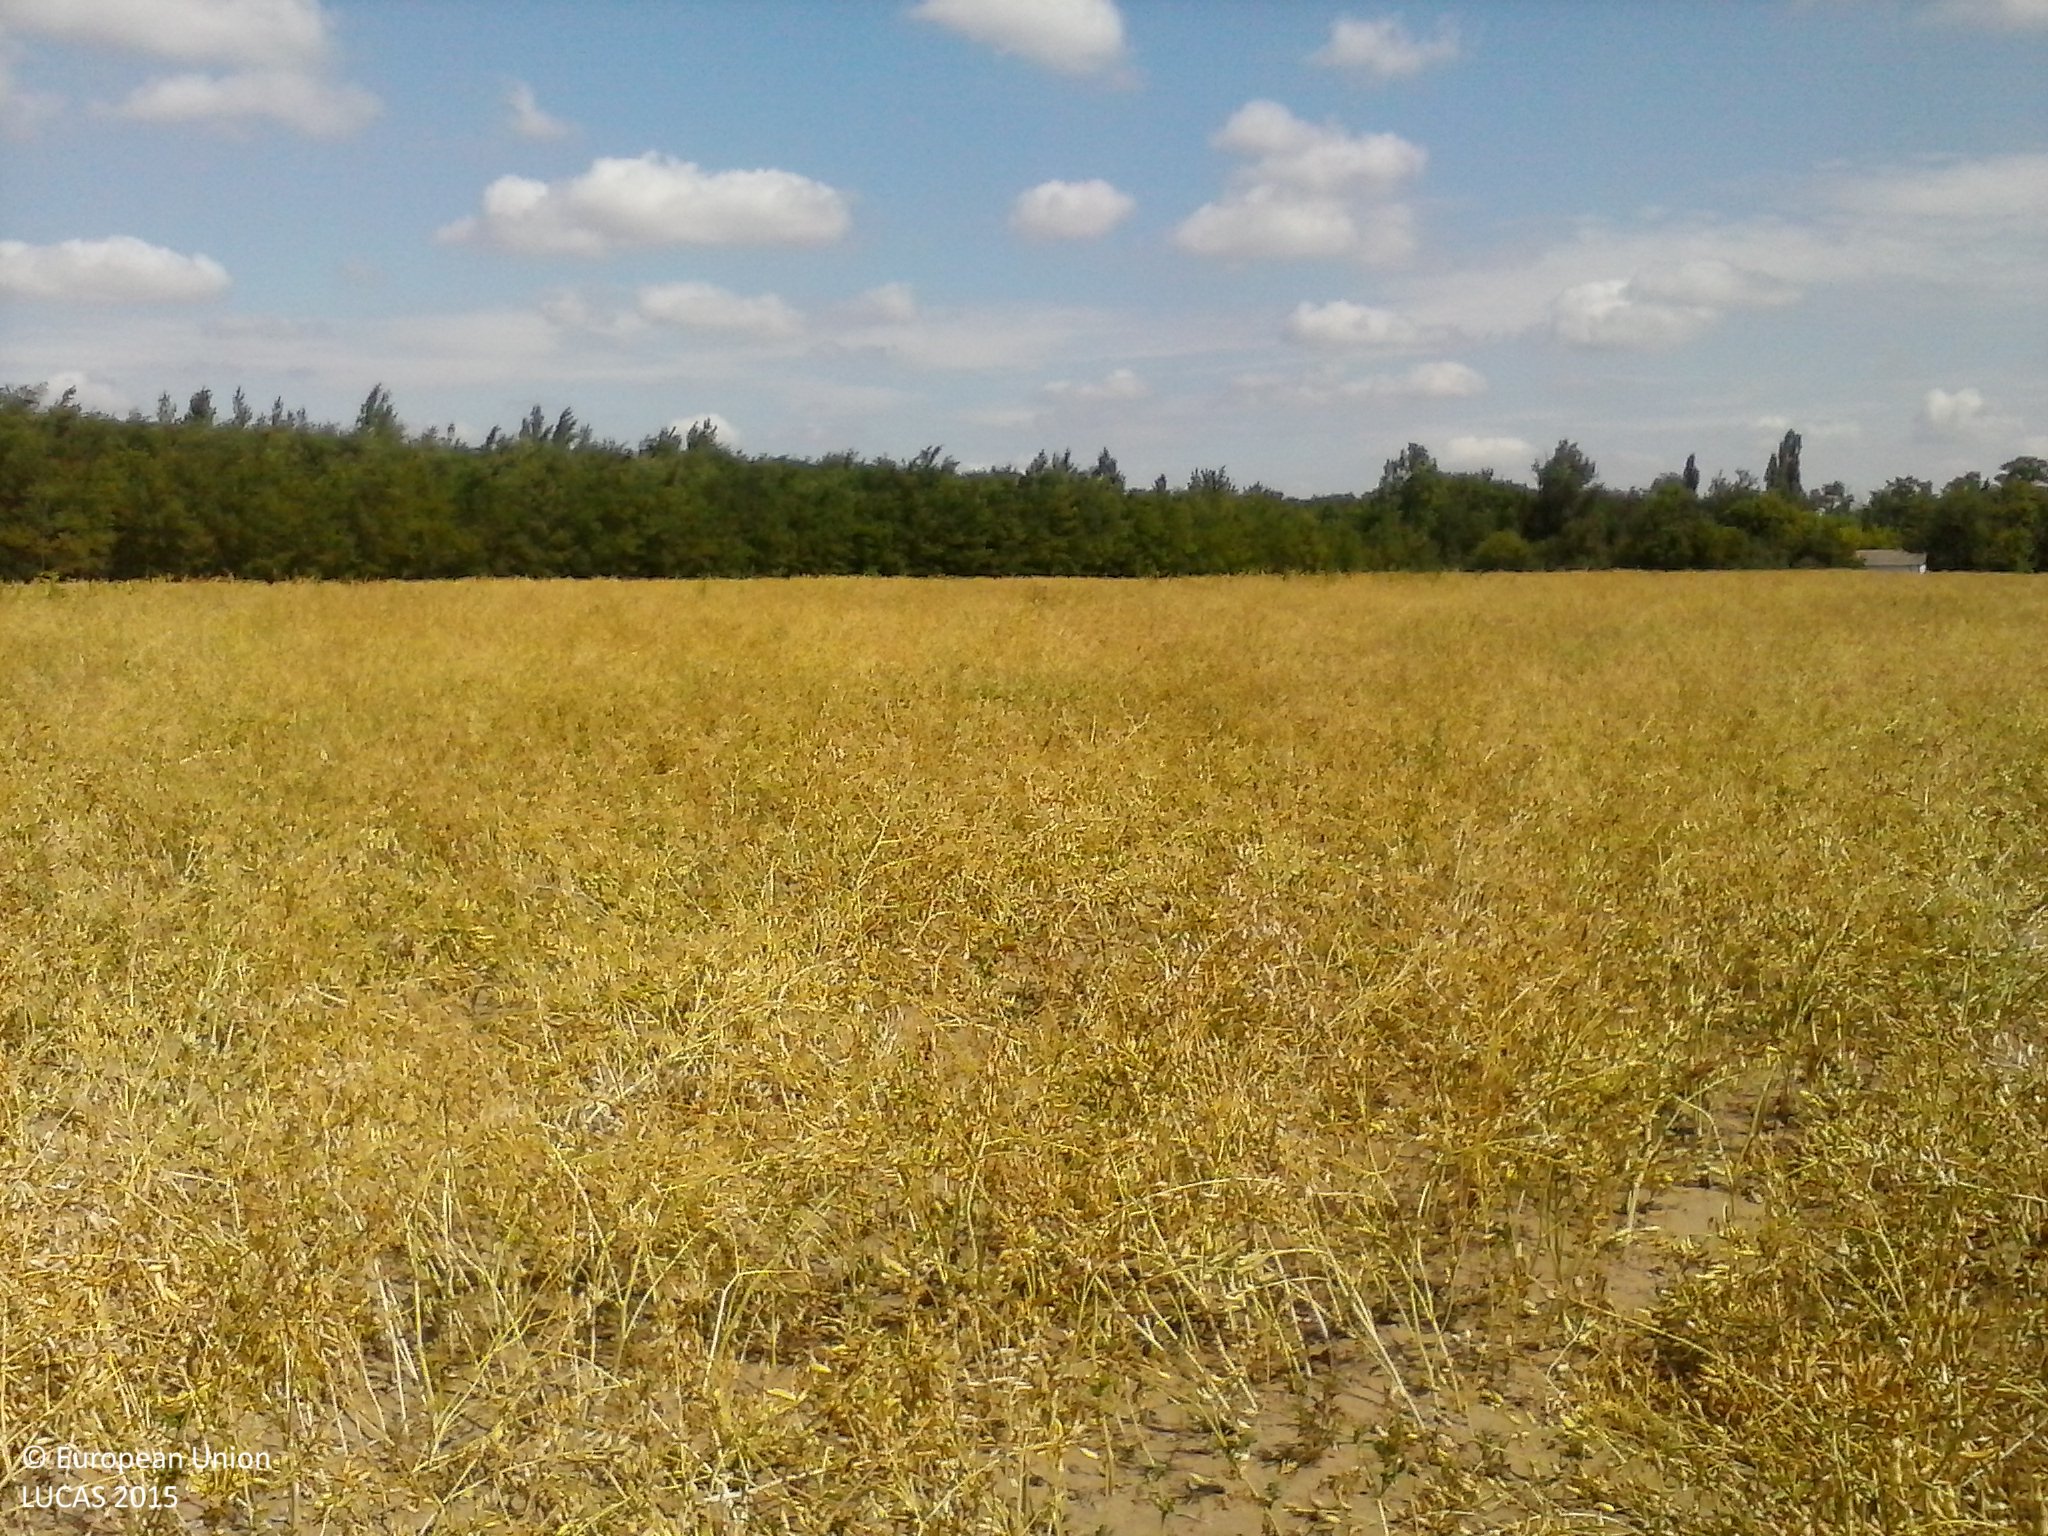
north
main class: Cropland
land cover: Other leguminous and mixtures for fodder
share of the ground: > 75 %
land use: Agriculture (excluding fallow land and kitchen gardens)
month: July
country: HU
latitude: 46.6062
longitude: 19.6147
